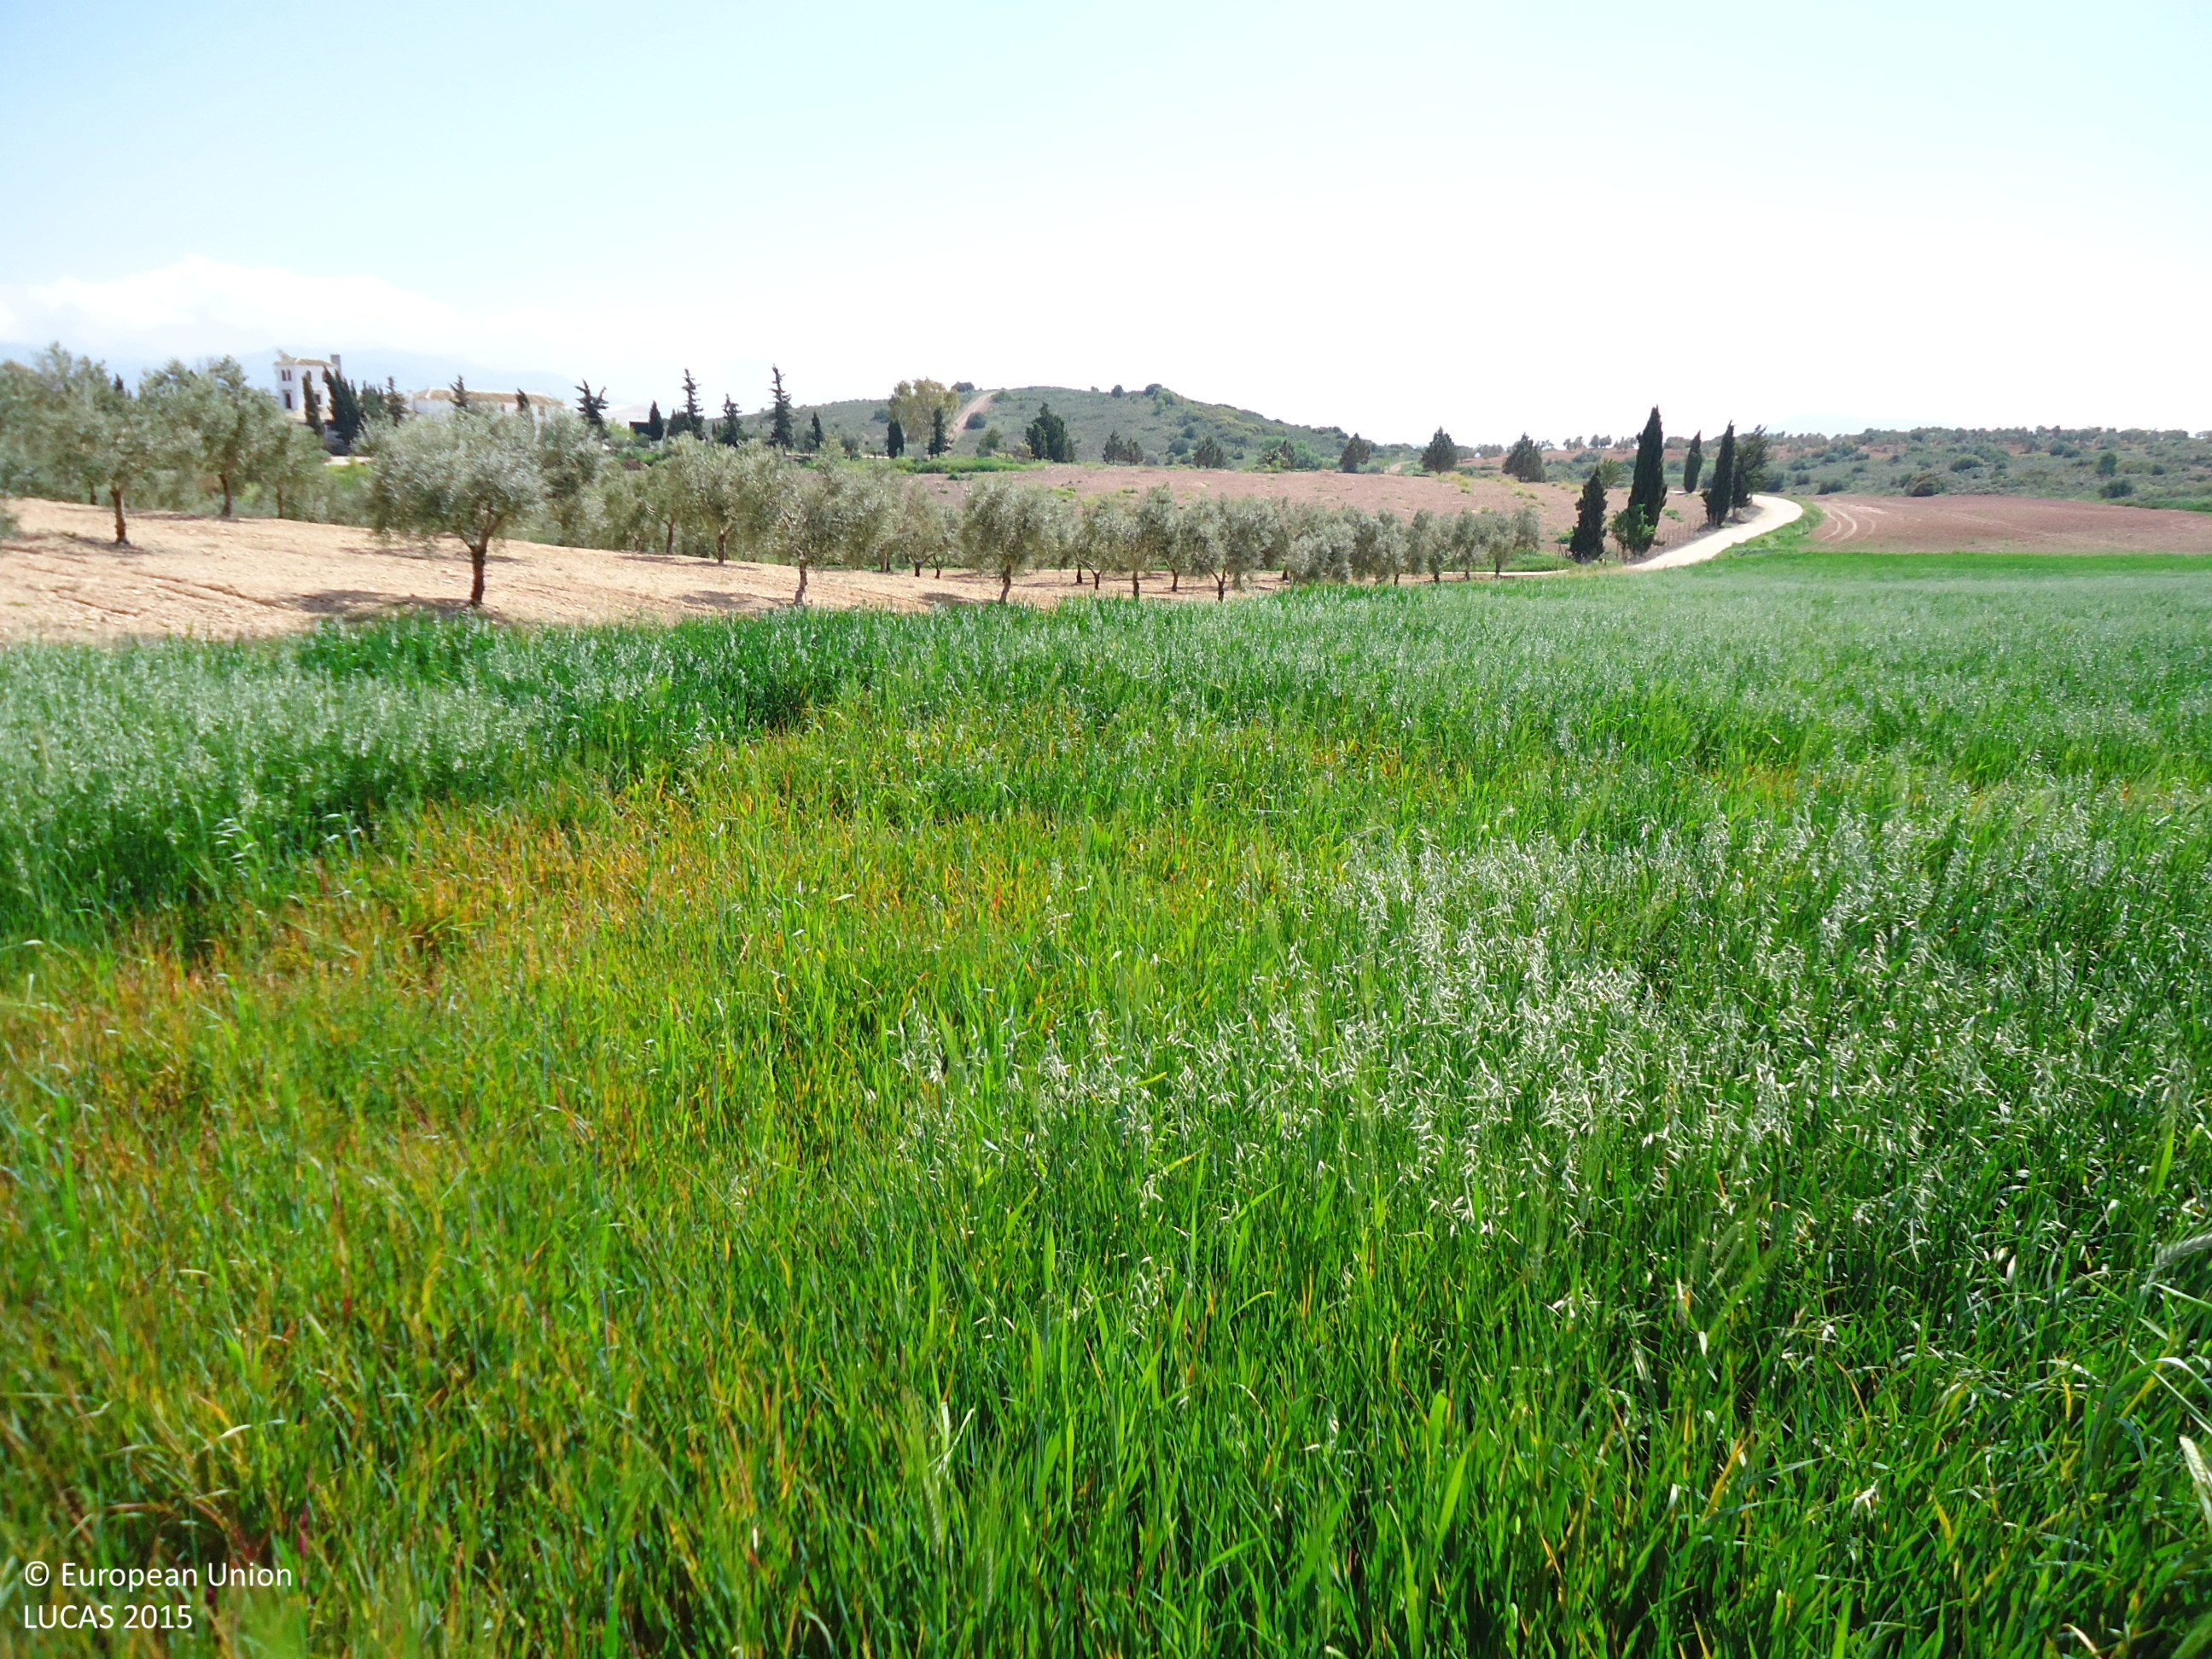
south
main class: Cropland
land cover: Oats
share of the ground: > 75 %
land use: Agriculture (excluding fallow land and kitchen gardens)
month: April
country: ES
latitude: 37.0414
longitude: -4.8073
